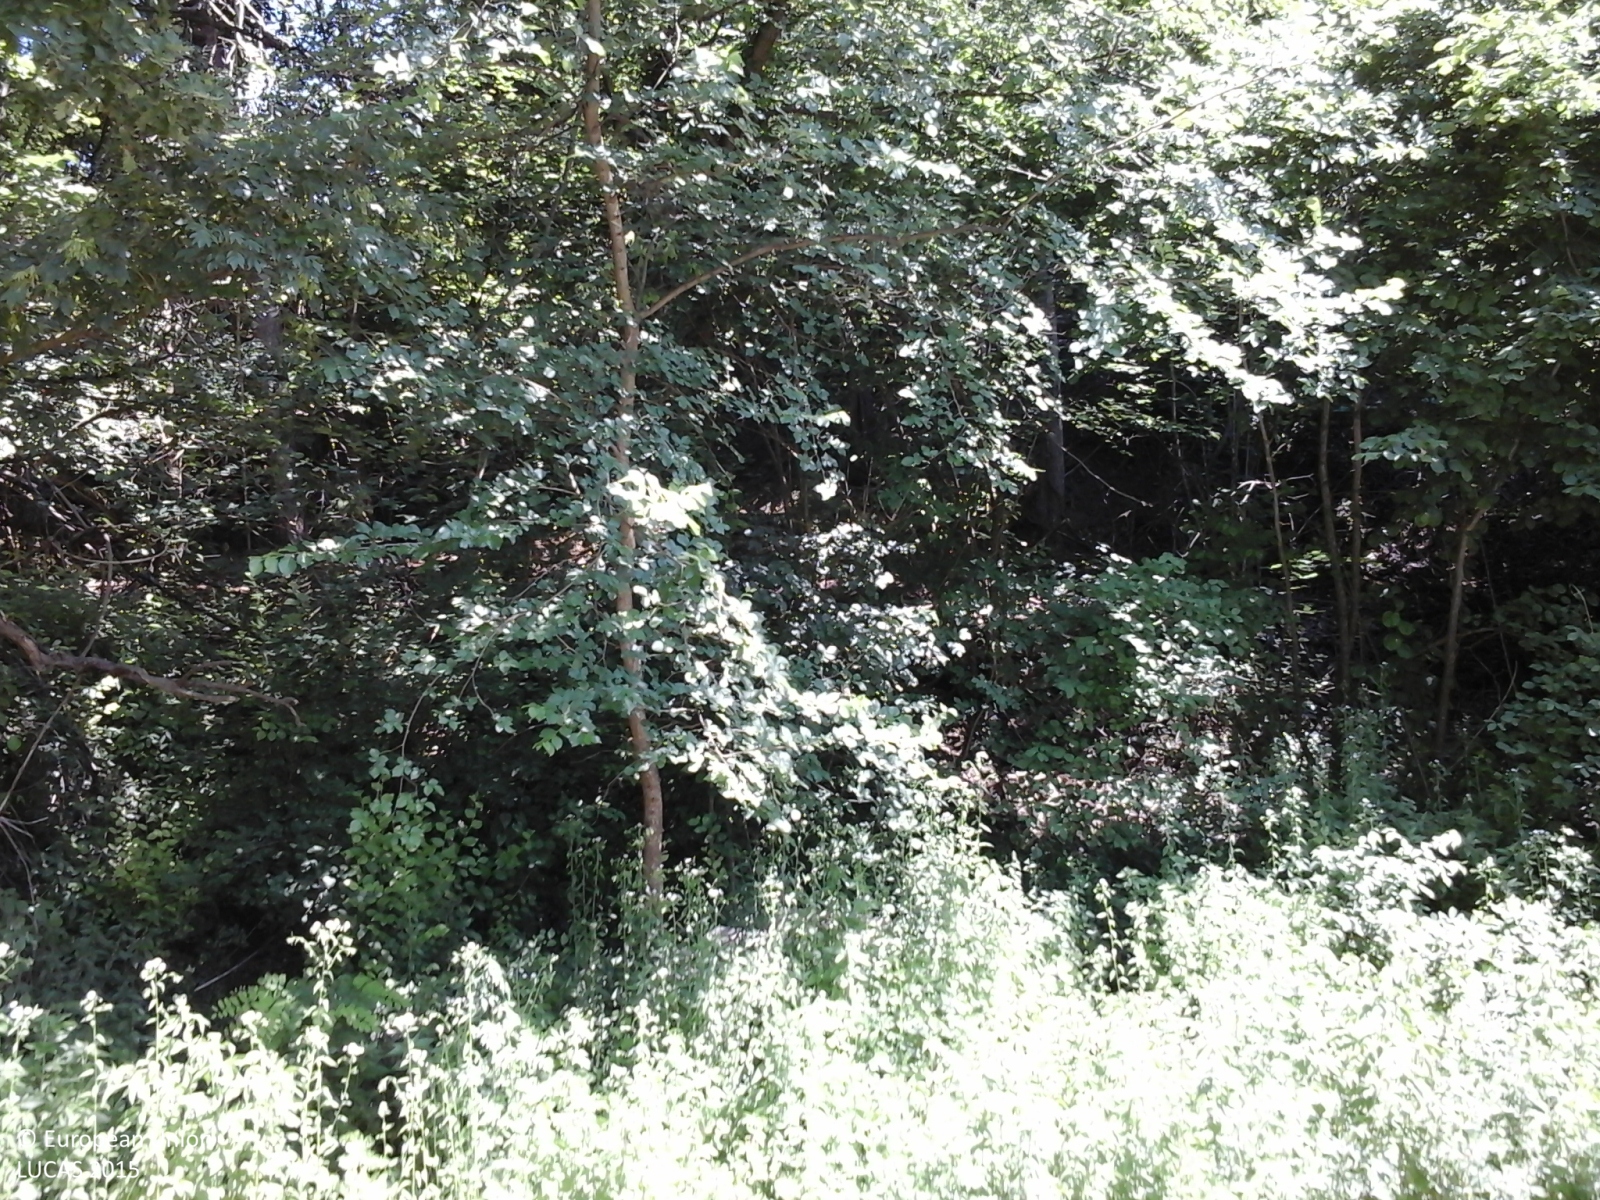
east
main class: Woodland
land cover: Broadleaved woodland
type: mesophytic deciduous forest
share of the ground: > 75 %
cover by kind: broadleaved forest trees 90 %, shrubs 10 %
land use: Forestry
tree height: > 5 m
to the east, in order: Broadleaved woodland; Tracks; Broadleaved woodland; Vineyards; Dry stone walls; Vineyards; Single bushes/trees; Dry stone walls; Vineyards; Tracks; Vineyards; Tracks; Electric lines; Grassland without tree/shrub cover; Tracks; Grassland without tree/shrub cover; Artificial constructions in urban areas; Grassland without tree/shrub cover
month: June
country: IT
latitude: 44.6060
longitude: 8.2271
